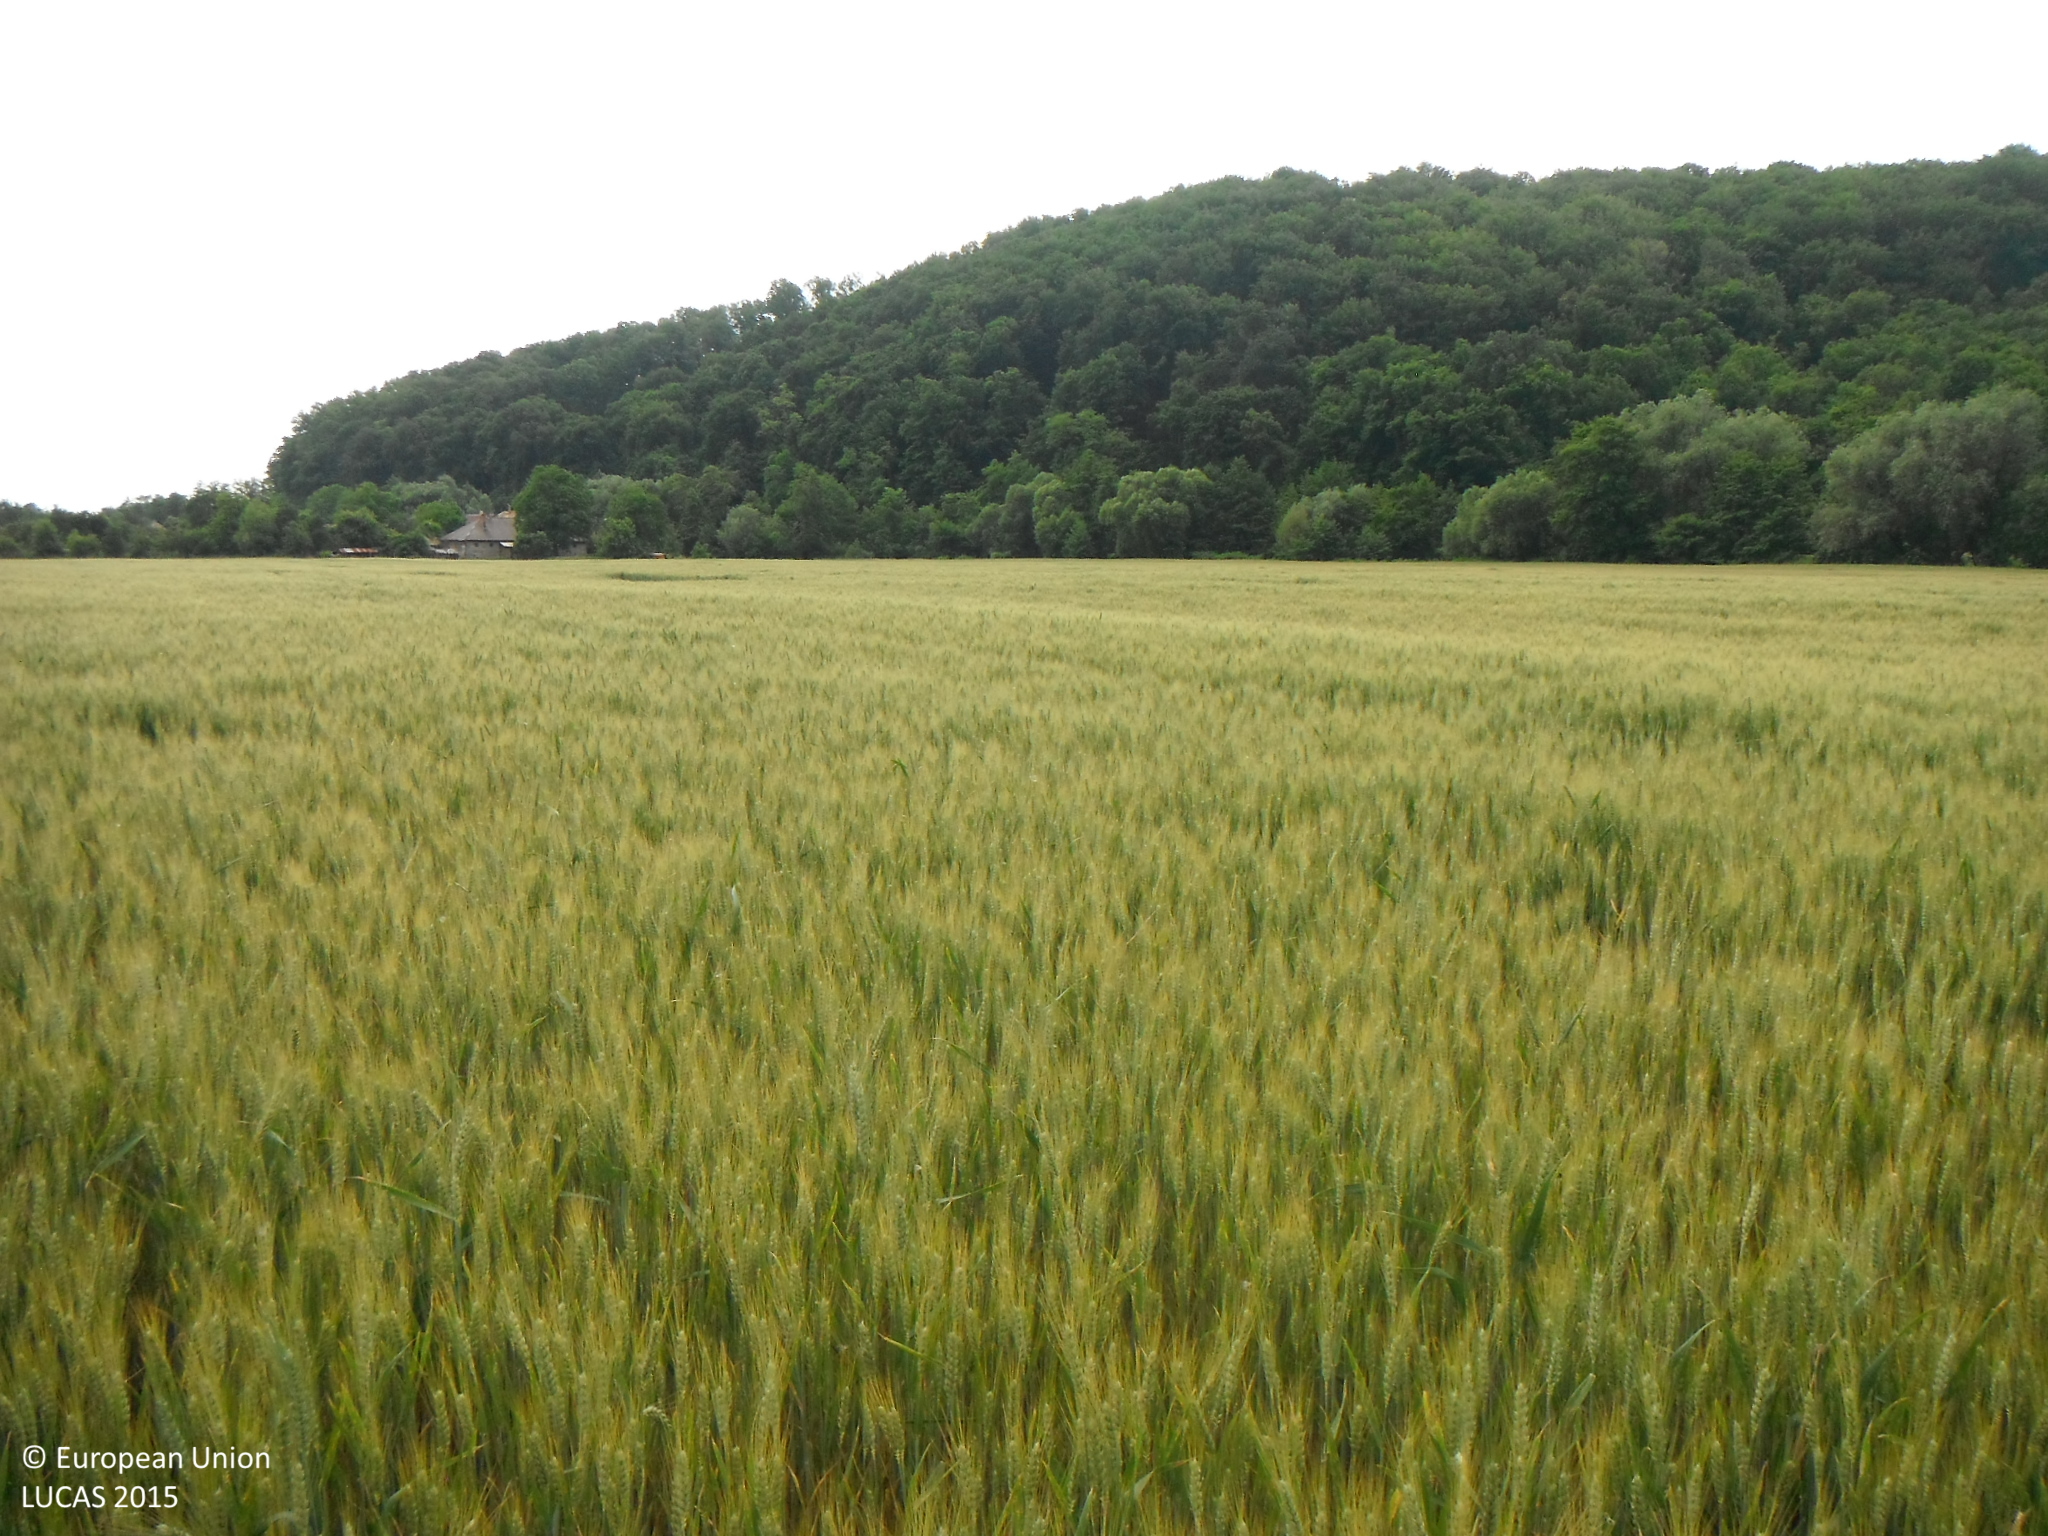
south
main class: Cropland
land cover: Durum wheat
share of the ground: > 75 %
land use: Agriculture (excluding fallow land and kitchen gardens)
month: June
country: SK
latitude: 48.4394
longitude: 19.5824
